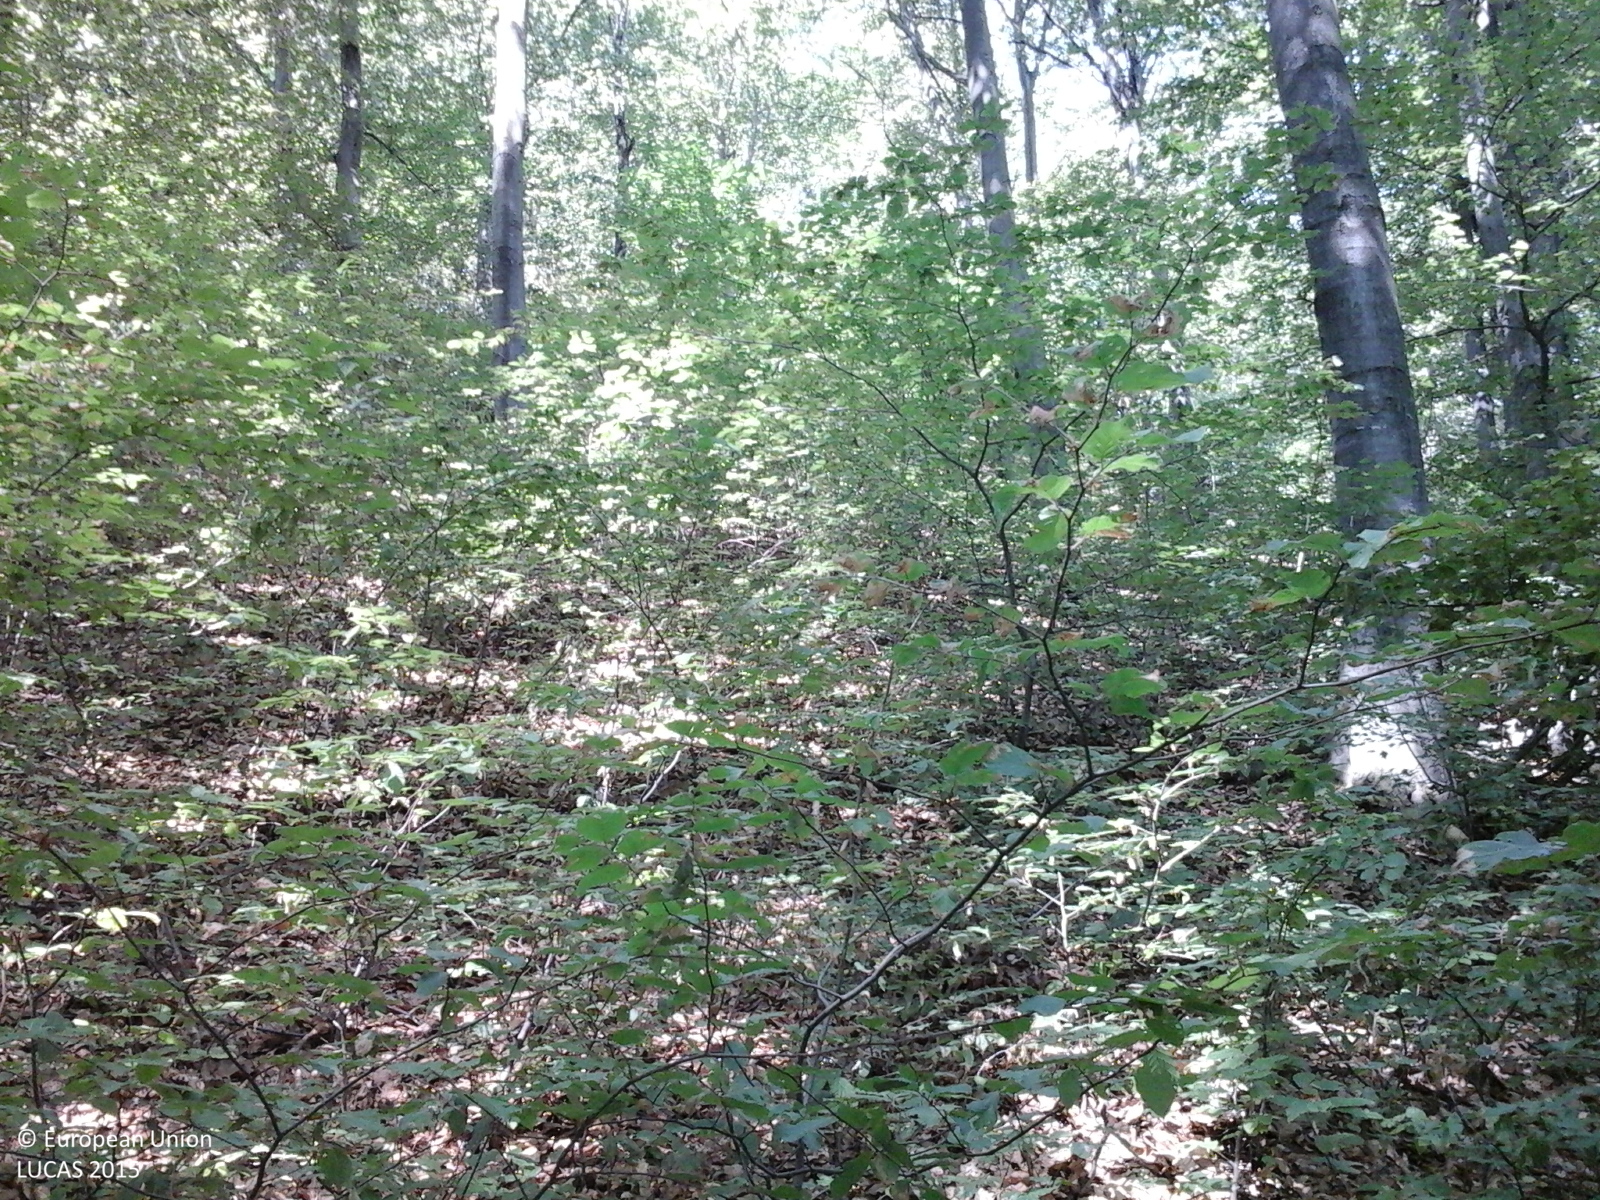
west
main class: Woodland
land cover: Broadleaved woodland
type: beech forest
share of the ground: > 75 %
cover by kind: broadleaved forest trees 100 %
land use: Forestry
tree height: > 5 m
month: June
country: RO
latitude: 46.5113
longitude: 26.8388
